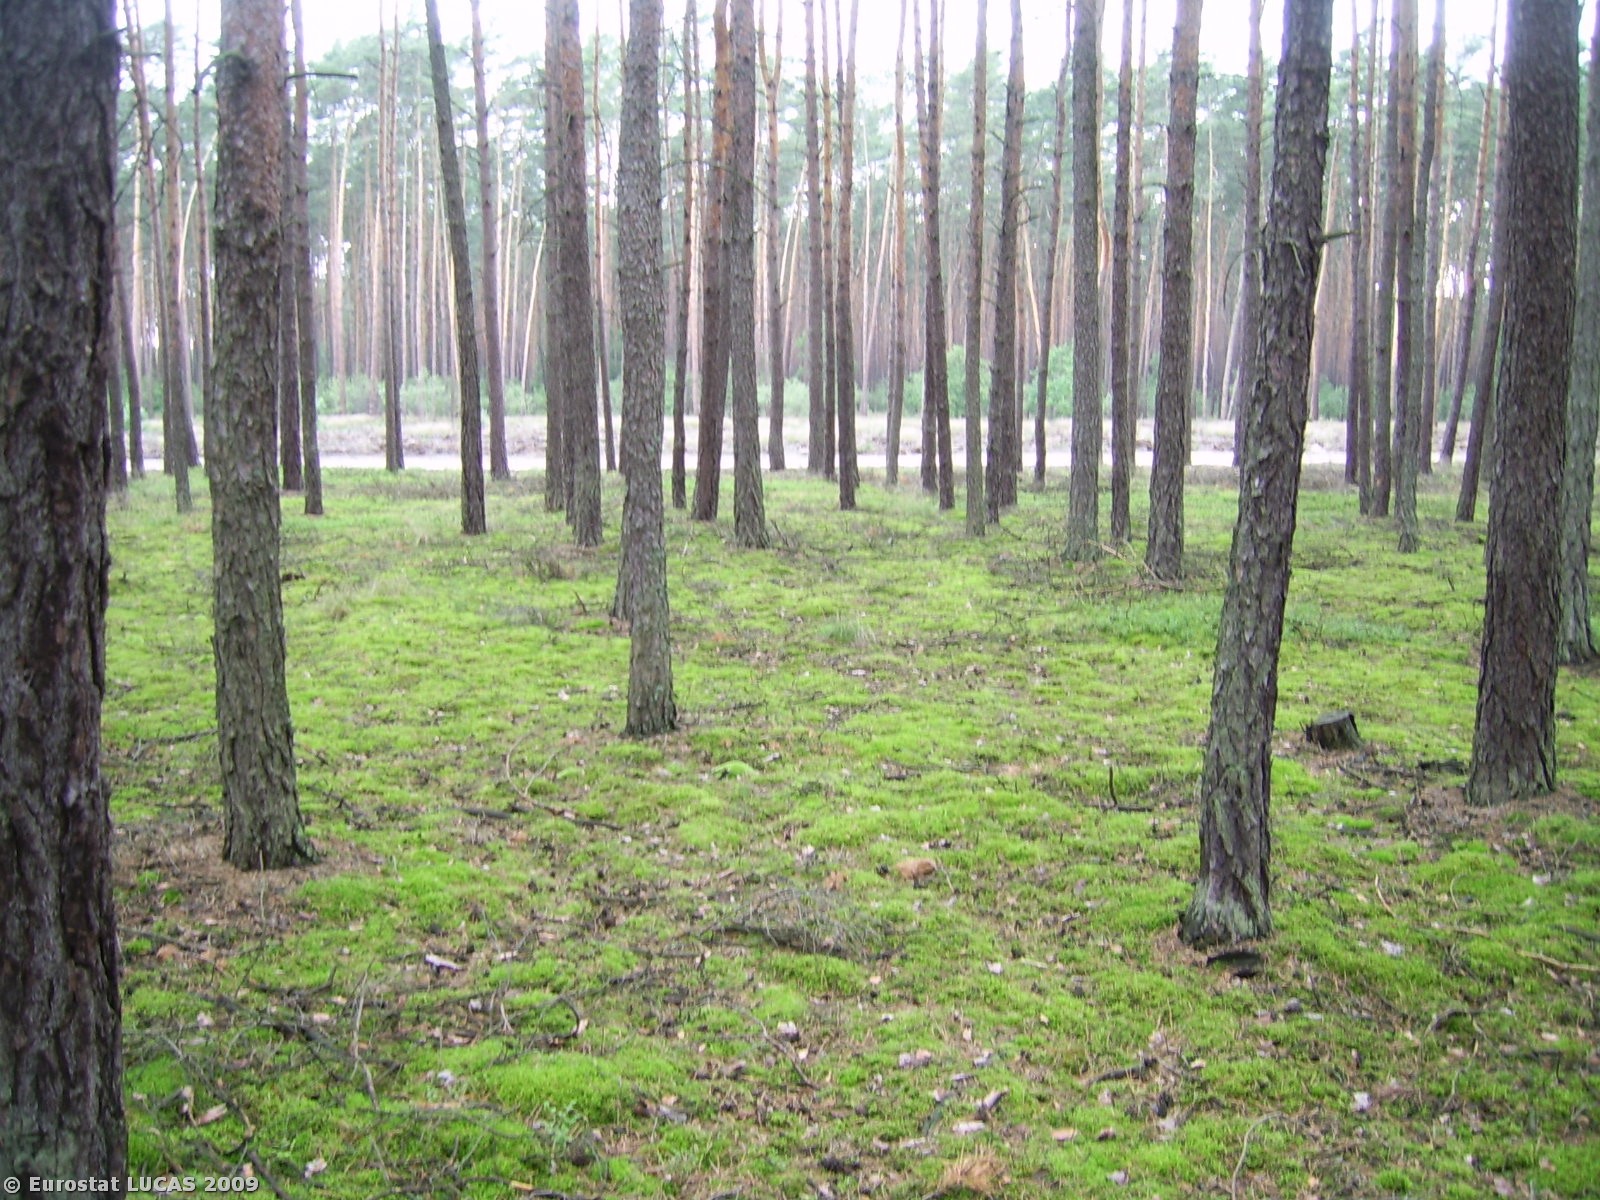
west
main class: Woodland
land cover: Coniferous woodland
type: hemiboreal forest and nemoral coniferous forest and mixed broadleaved-coniferous forest
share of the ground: 50 - 75 %
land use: Forestry
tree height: > 5 m
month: June
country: PL
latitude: 51.5474
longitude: 17.7291
